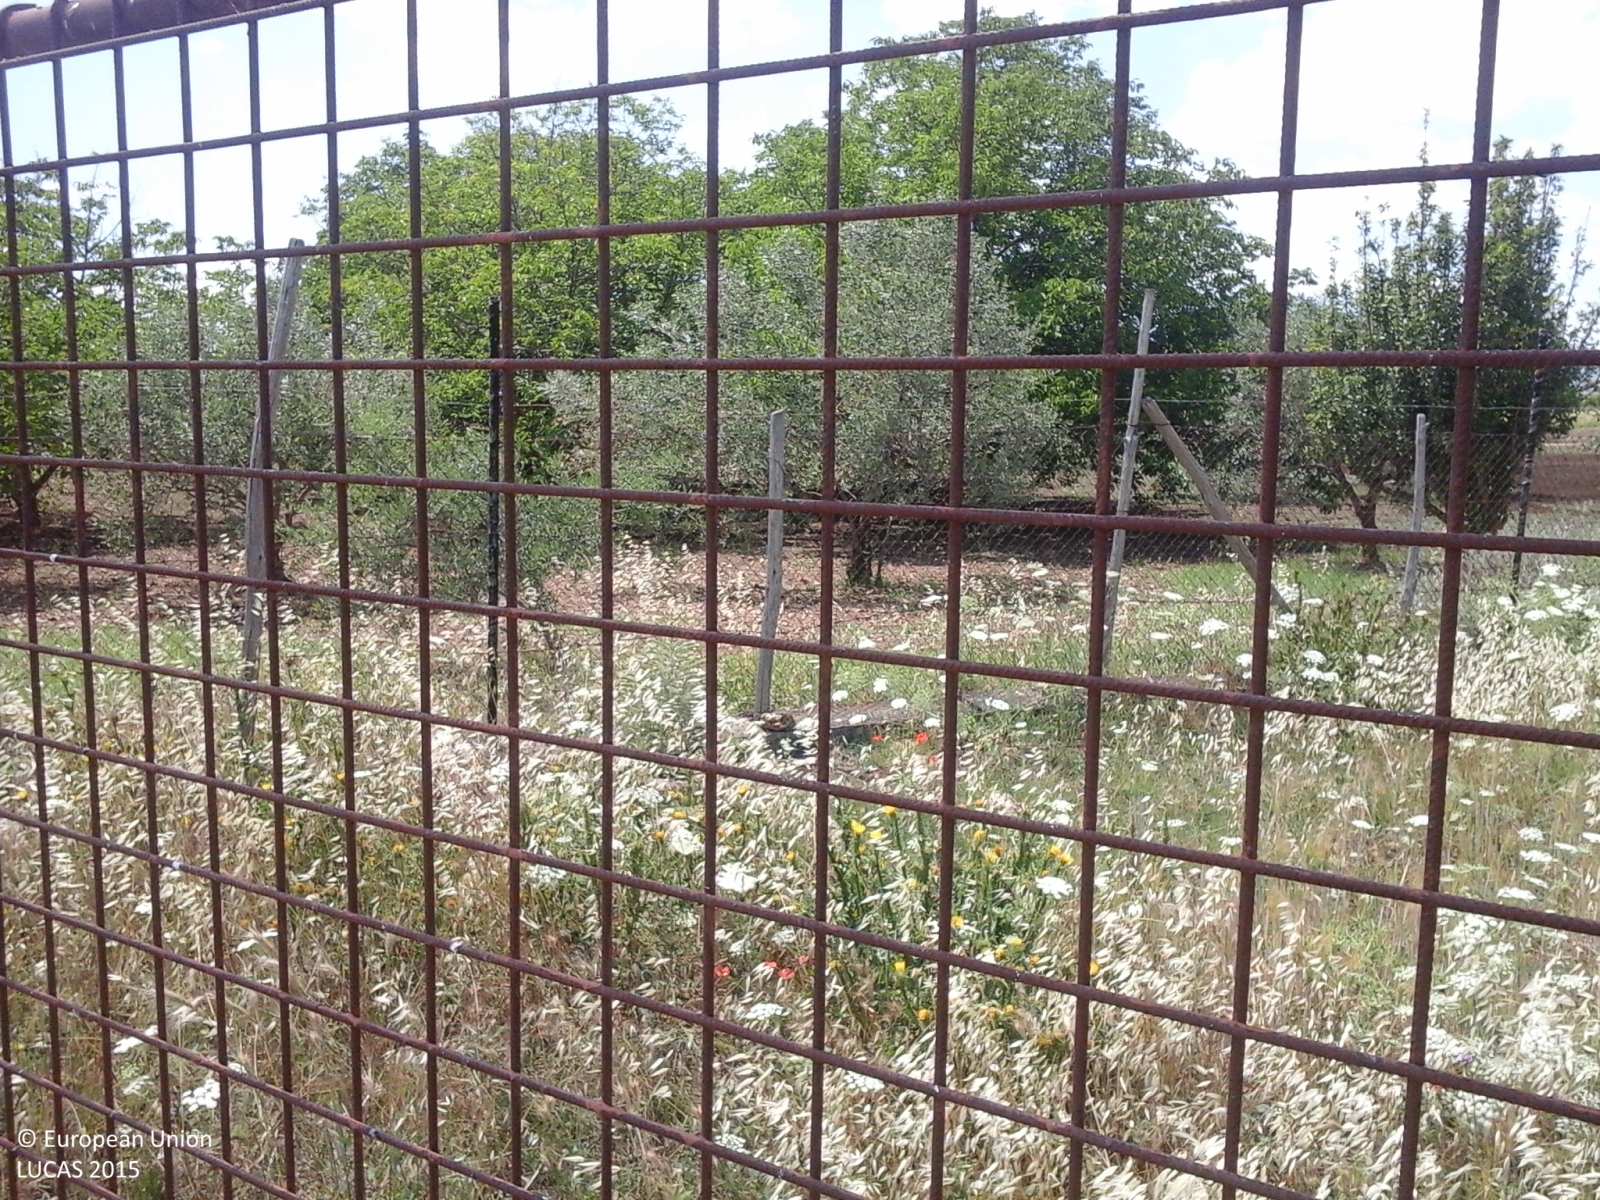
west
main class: Grassland
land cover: Spontaneously vegetated surfaces
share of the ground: > 75 %
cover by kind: herbaceous plants 90 %, unconsolidated bare surface 10 %
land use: Fallow land
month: June
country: IT
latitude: 37.6628
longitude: 14.4233
